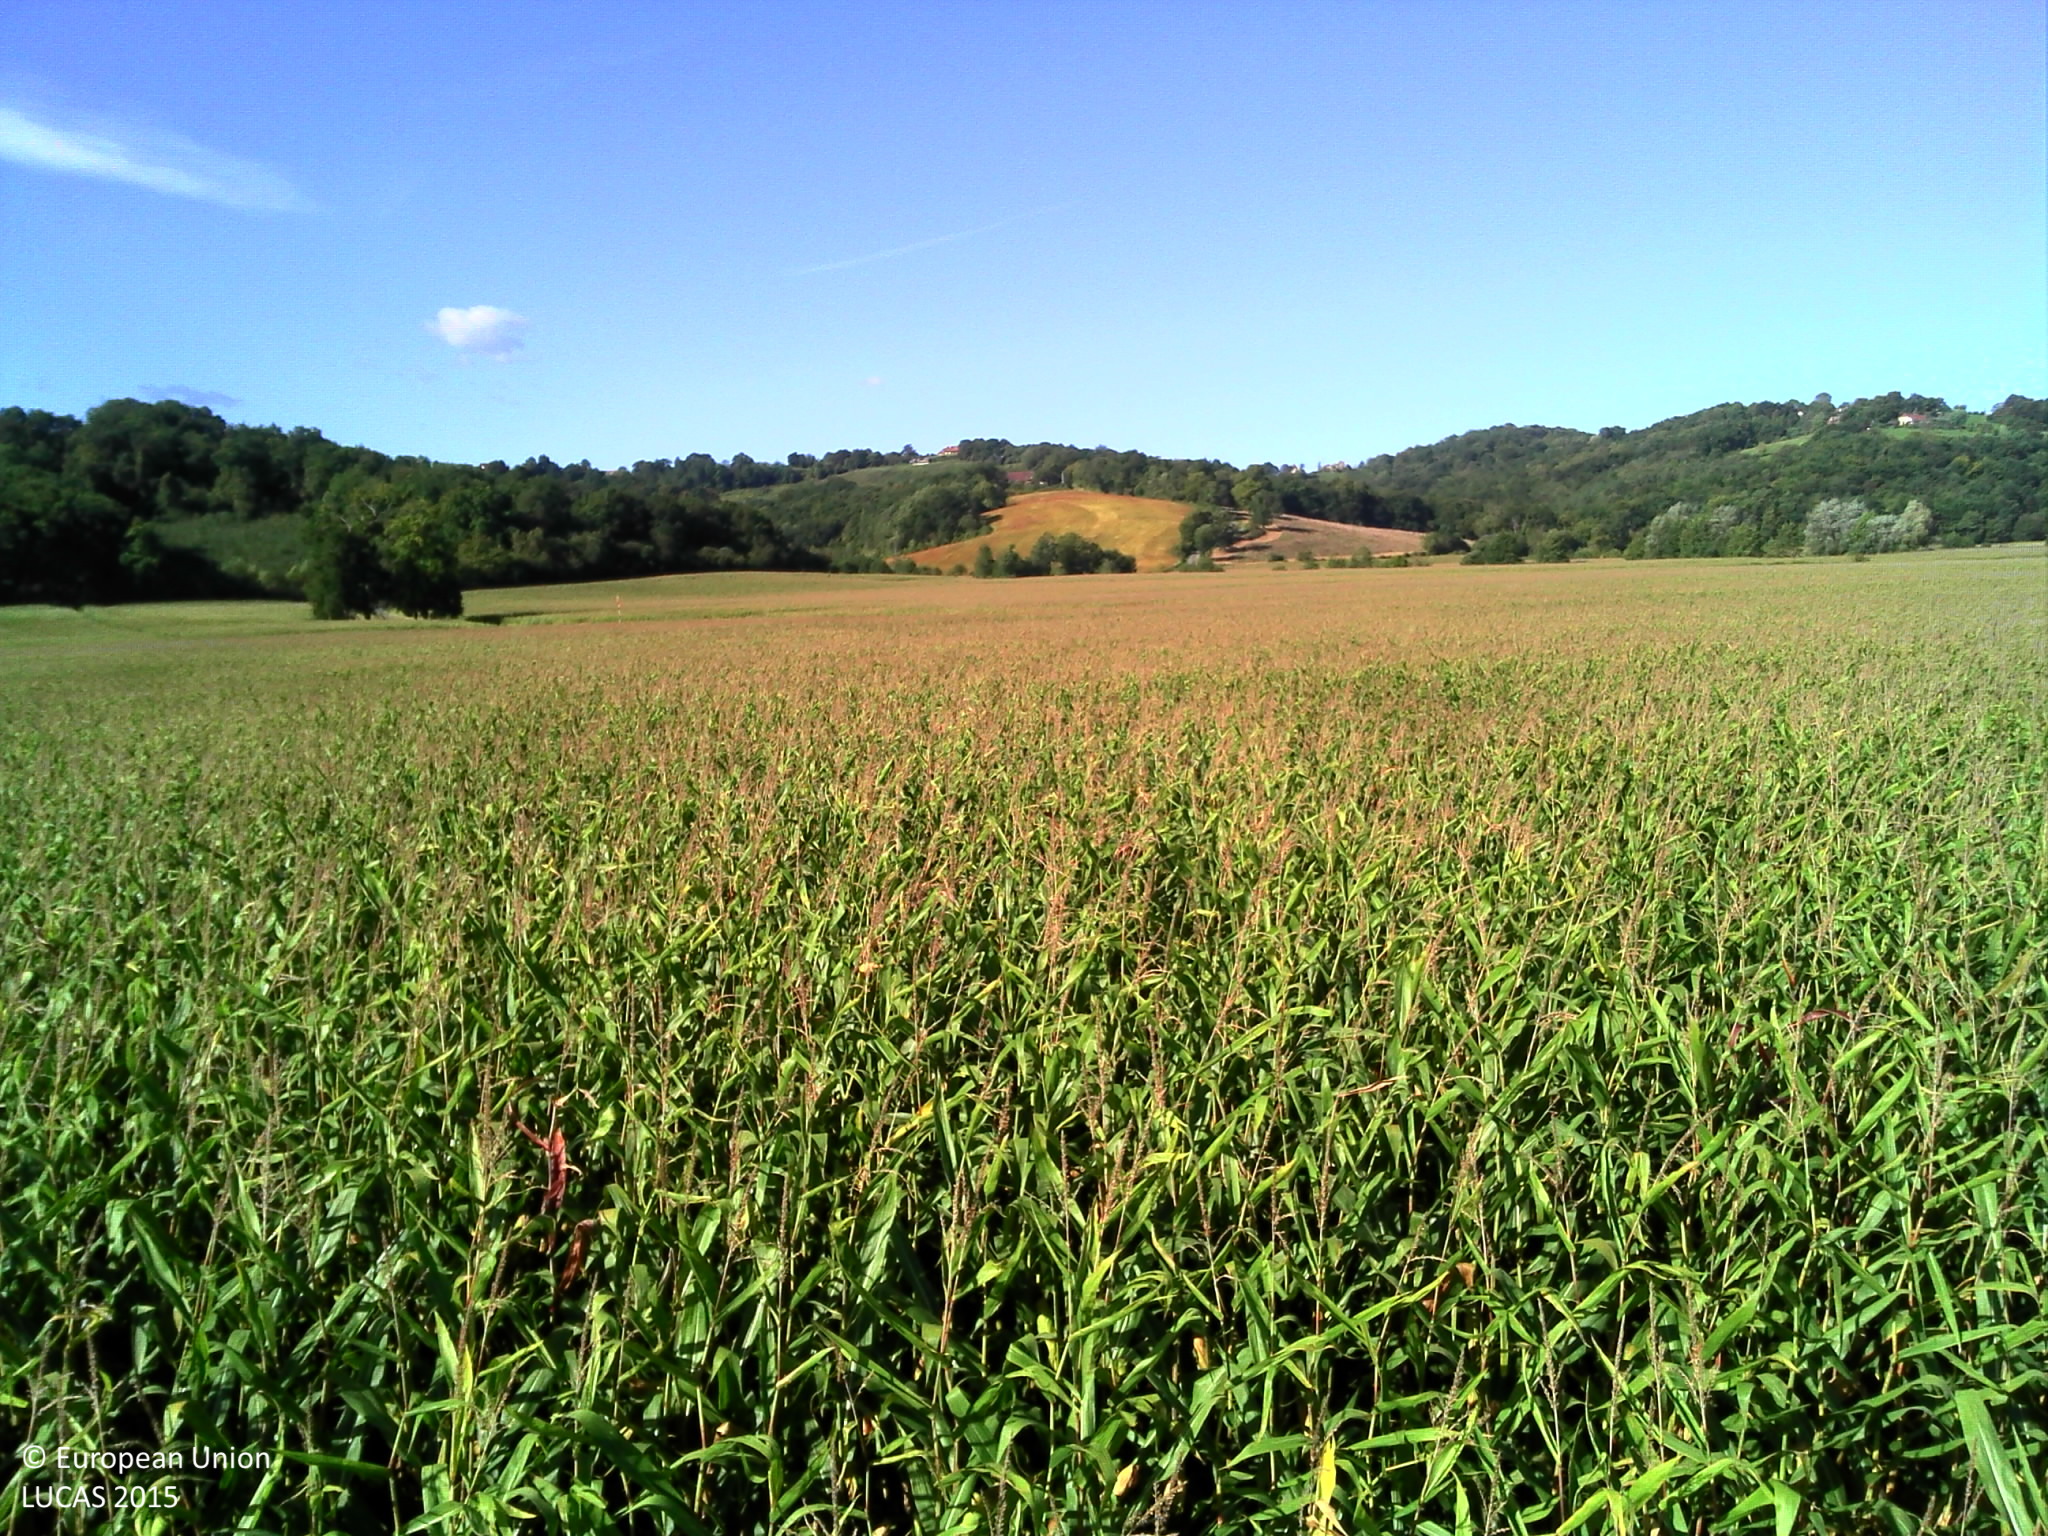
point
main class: Cropland
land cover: Maize
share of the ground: > 75 %
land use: Agriculture (excluding fallow land and kitchen gardens)
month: September
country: FR
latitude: 43.4477
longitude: -0.7241
